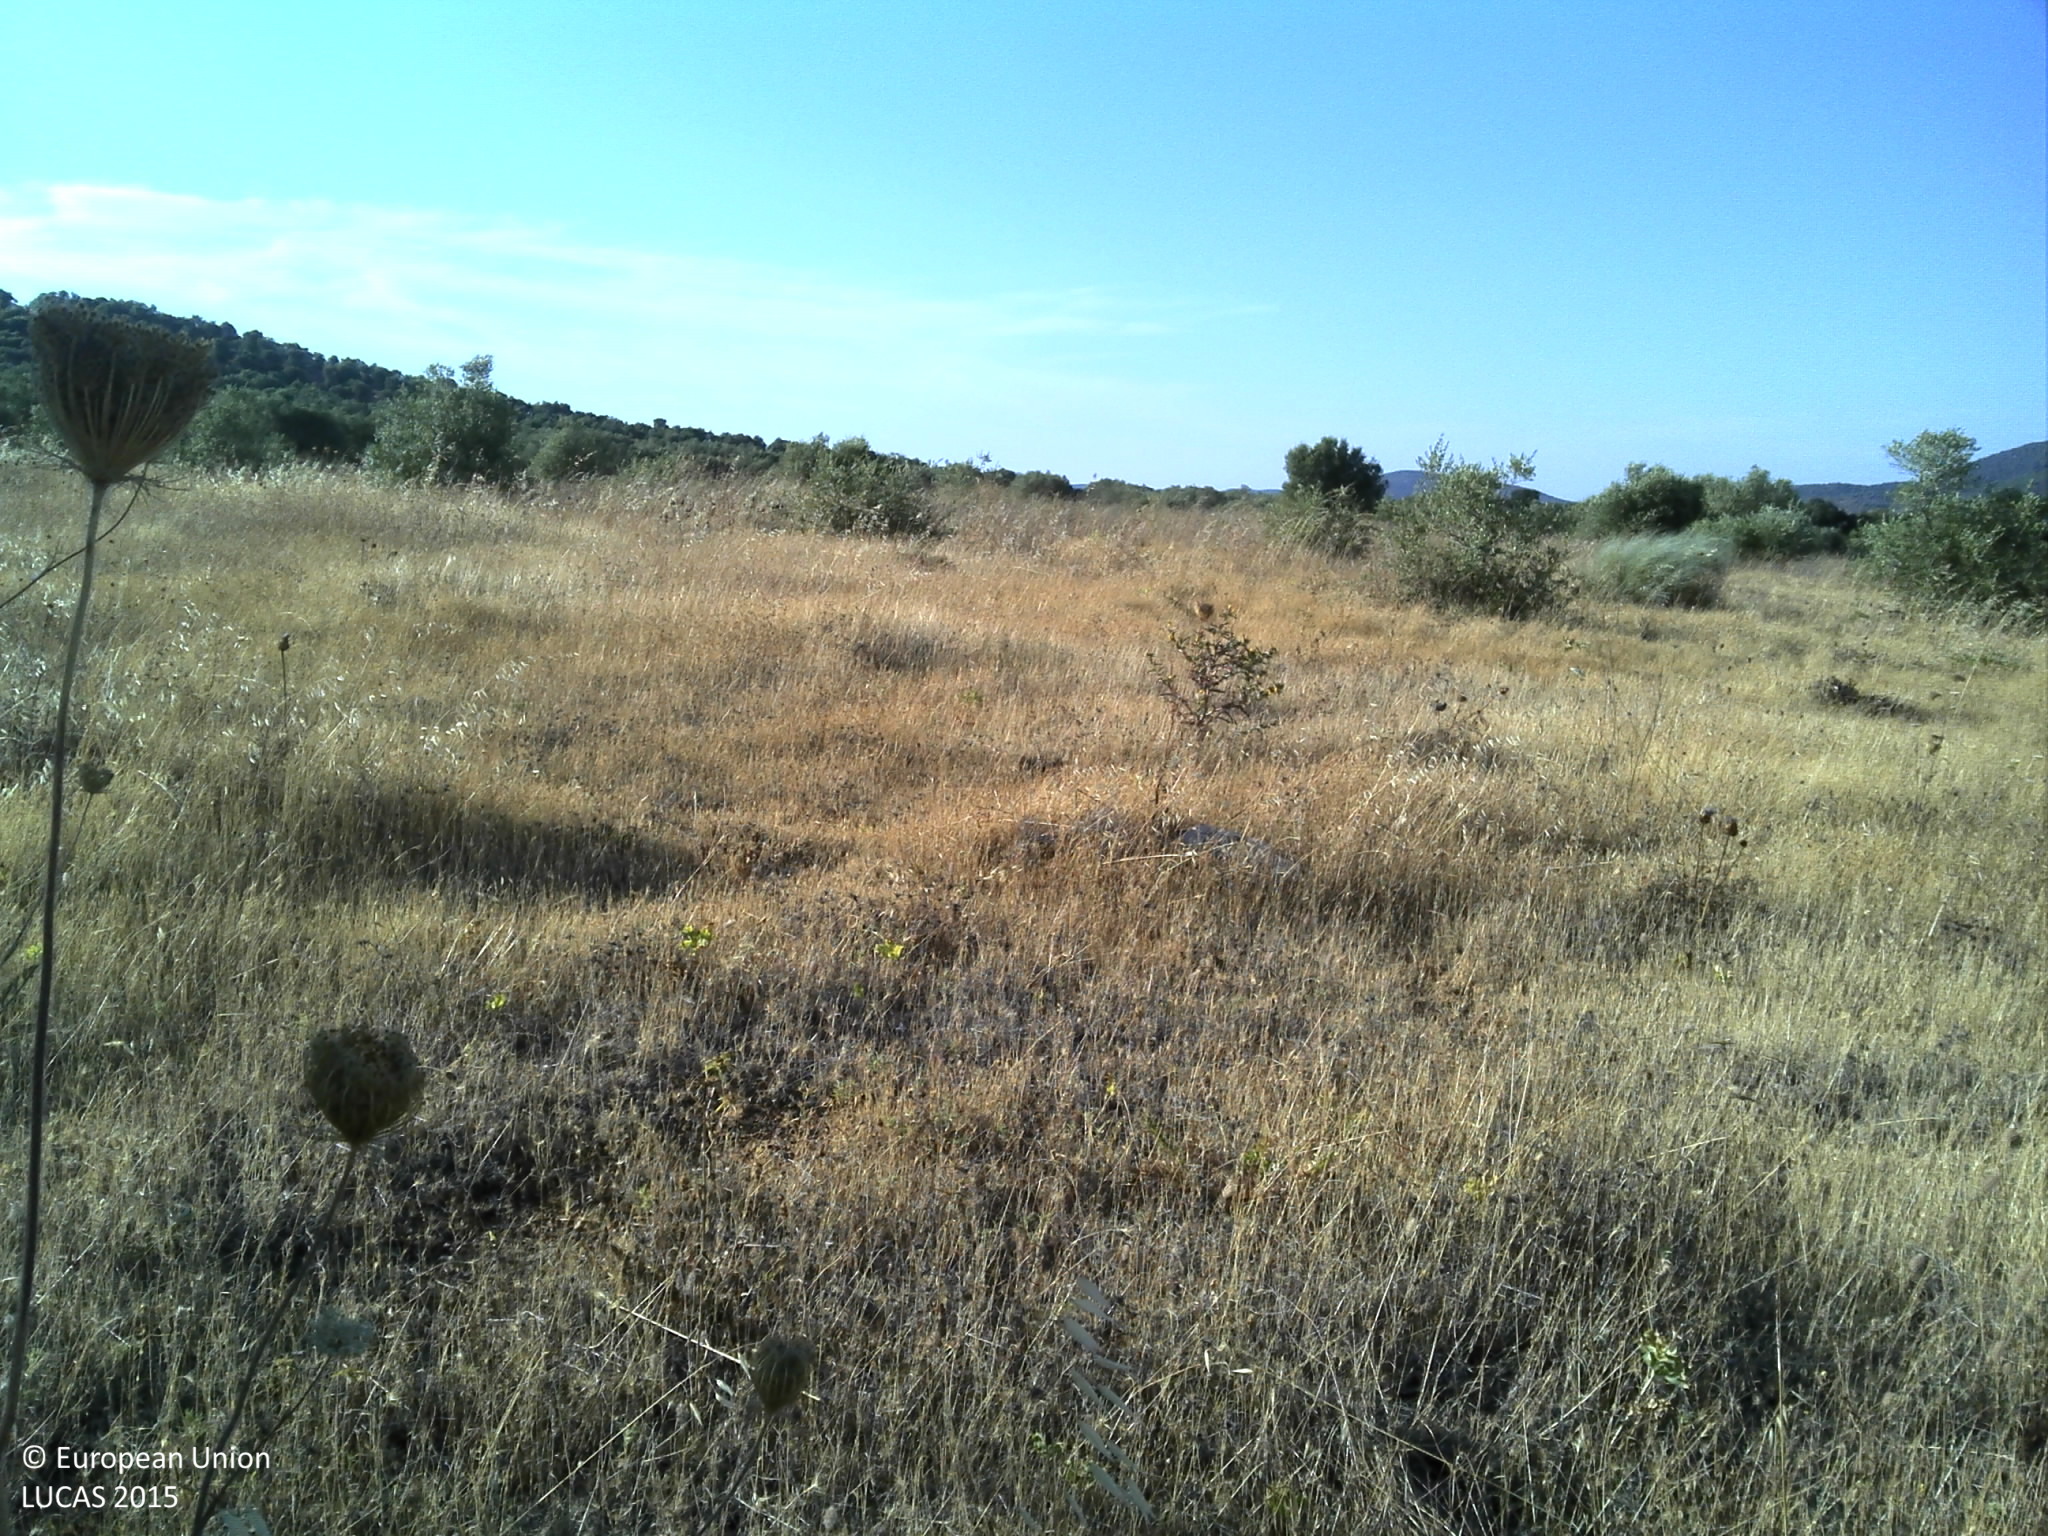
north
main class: Cropland
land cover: Olive groves
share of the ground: 10 - 25 %
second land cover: Grassland without tree/shrub cover
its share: 50 - 75 %
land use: Agriculture (excluding fallow land and kitchen gardens)
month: June
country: PT
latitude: 37.9732
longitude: -7.3297
